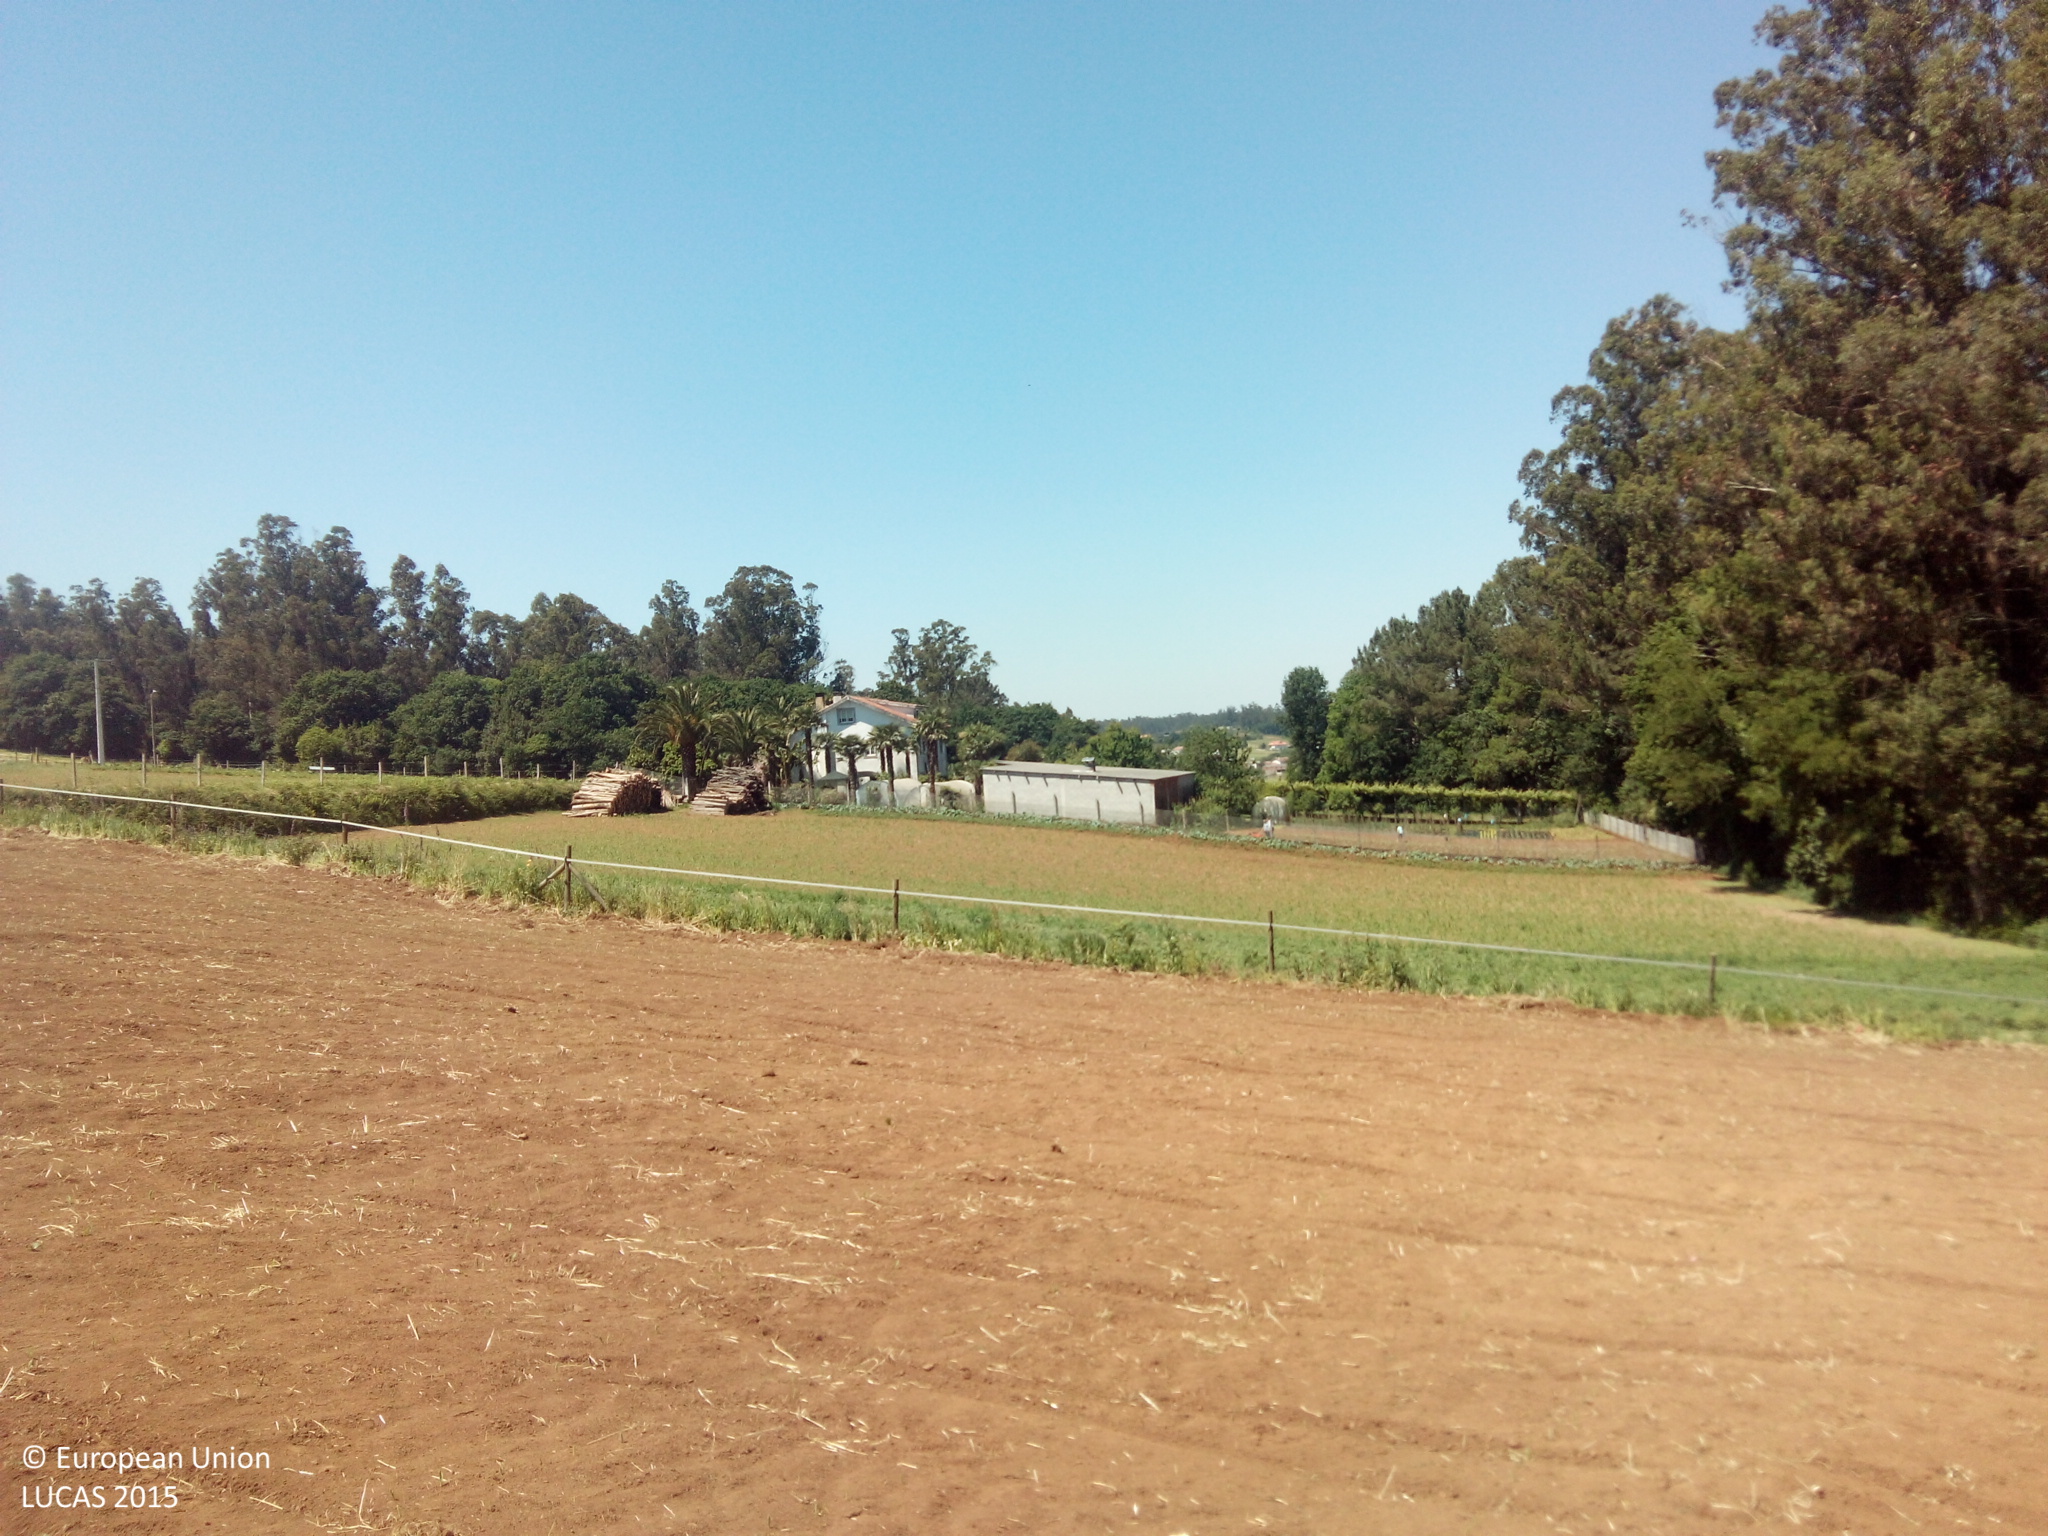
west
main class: Cropland
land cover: Maize
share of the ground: < 10 %
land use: Agriculture (excluding fallow land and kitchen gardens)
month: May
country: ES
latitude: 42.8239
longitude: -8.4615
